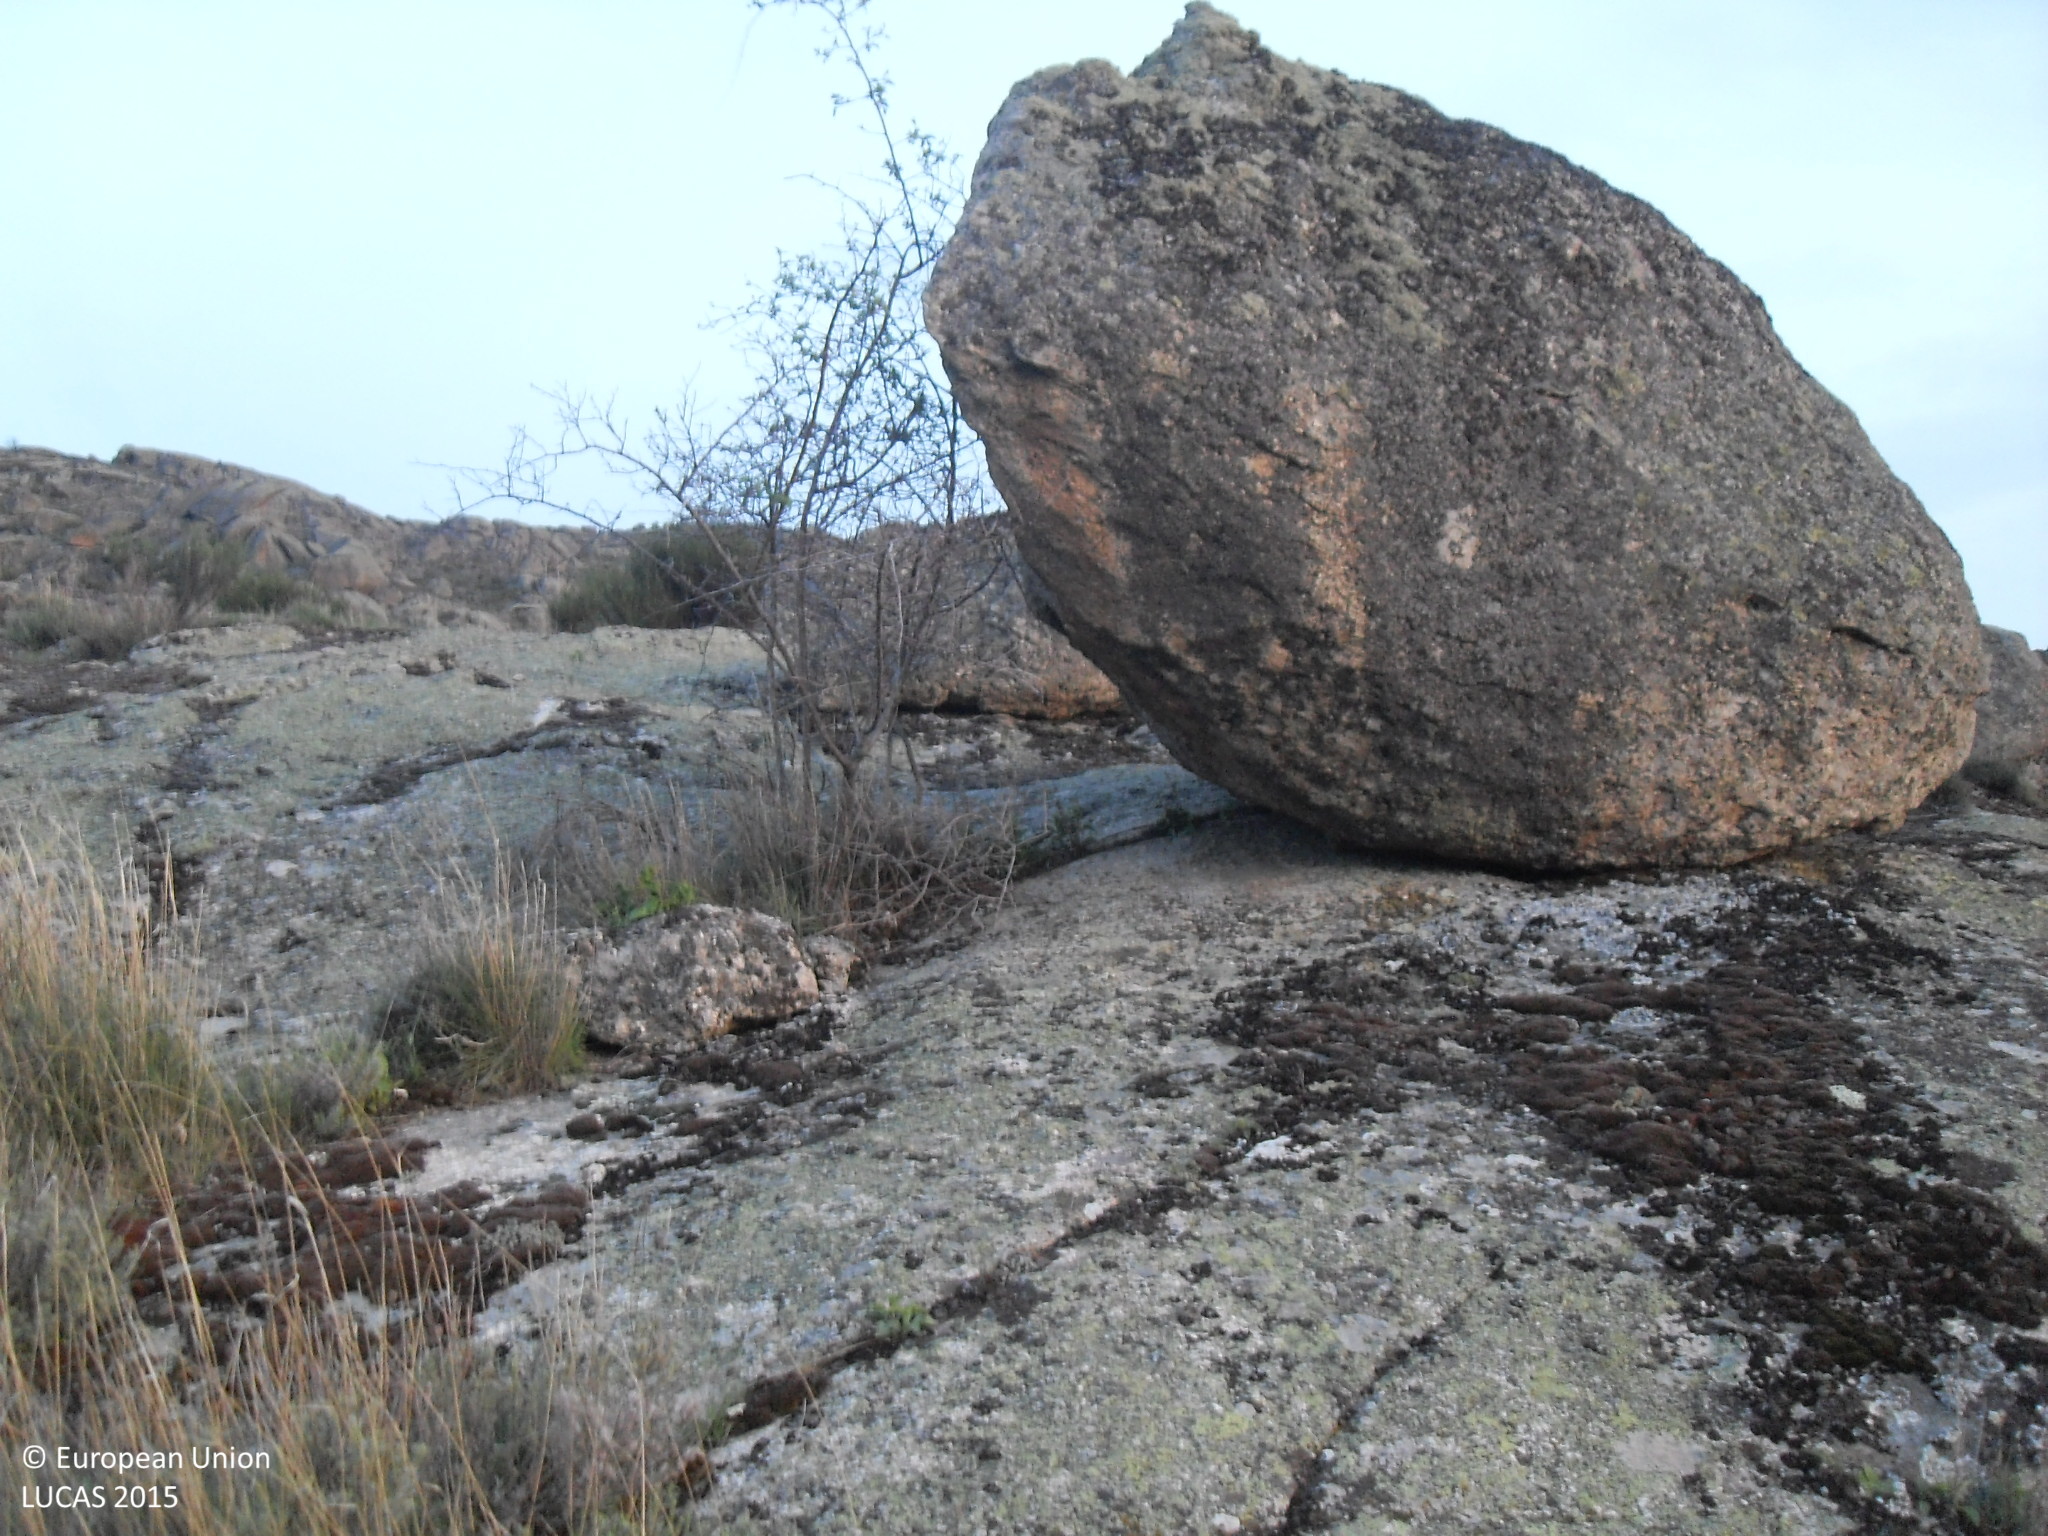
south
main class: Grassland
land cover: Grassland without tree/shrub cover
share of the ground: > 75 %
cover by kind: consolidated bare surface 80 %, herbaceous plants 20 %
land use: Agriculture (excluding fallow land and kitchen gardens)
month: May
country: ES
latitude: 40.5328
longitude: -4.9207
